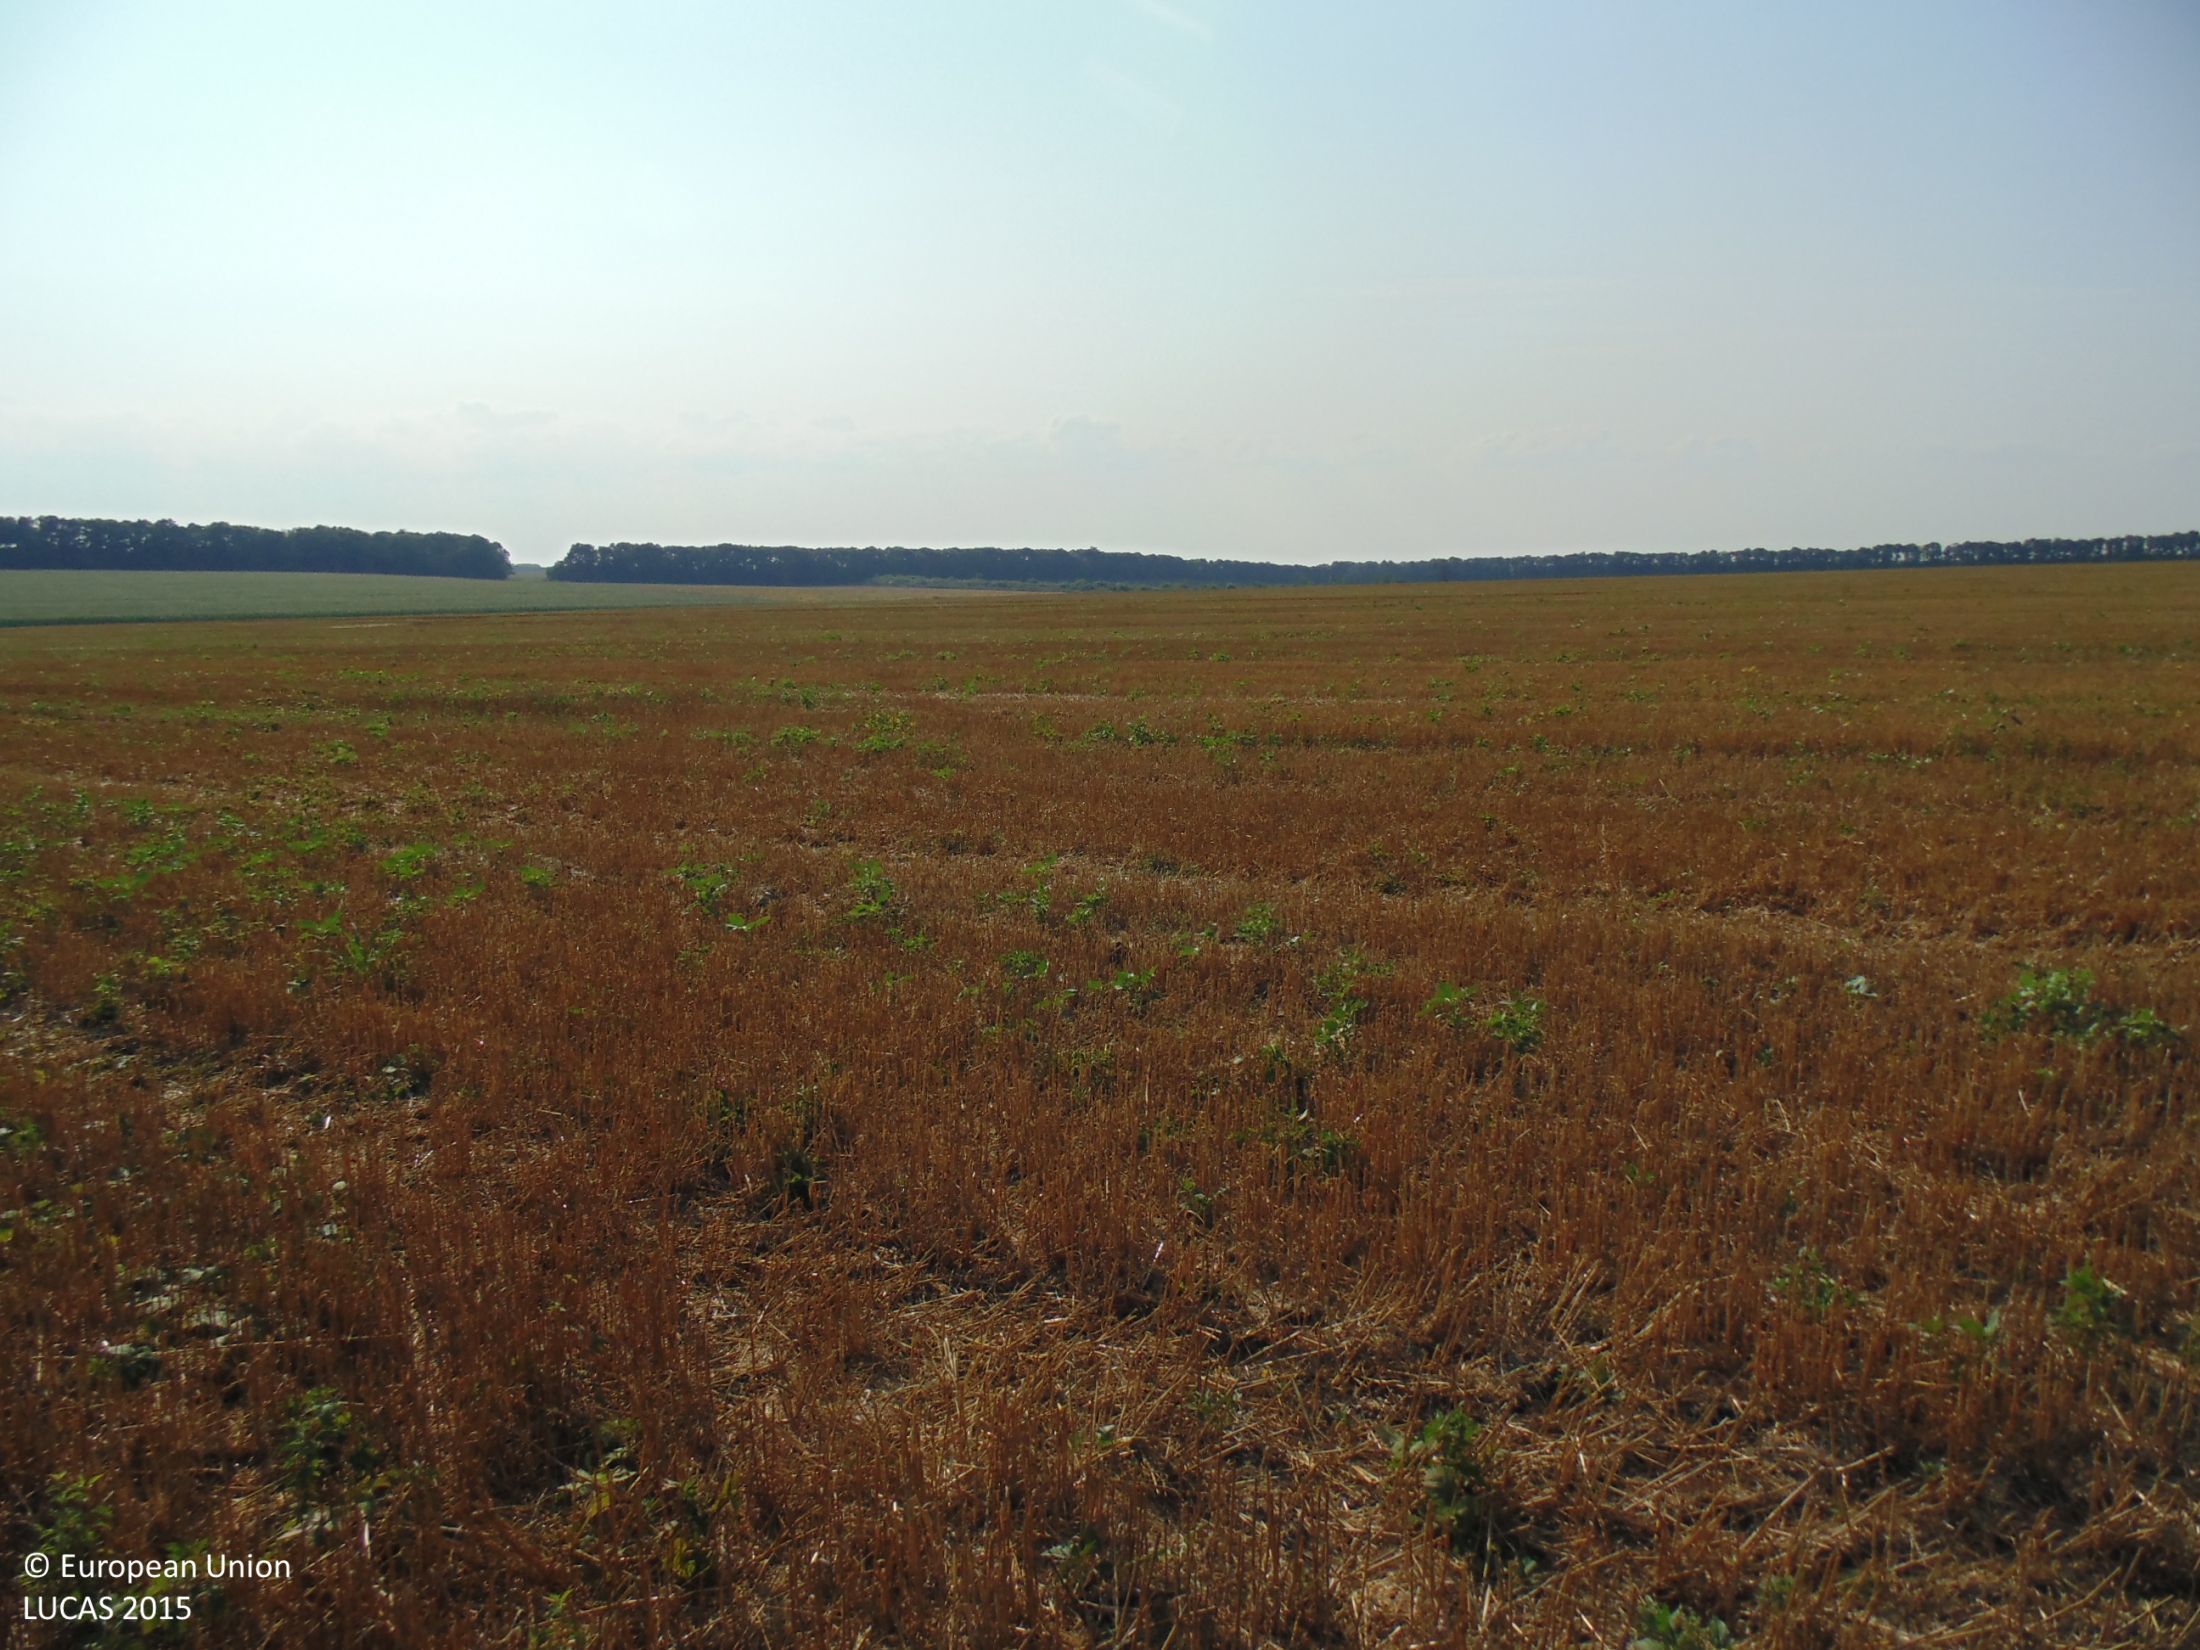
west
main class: Cropland
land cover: Common wheat
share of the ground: 25 - 50 %
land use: Agriculture (excluding fallow land and kitchen gardens)
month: July
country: BG
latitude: 43.5740
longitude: 27.9896
